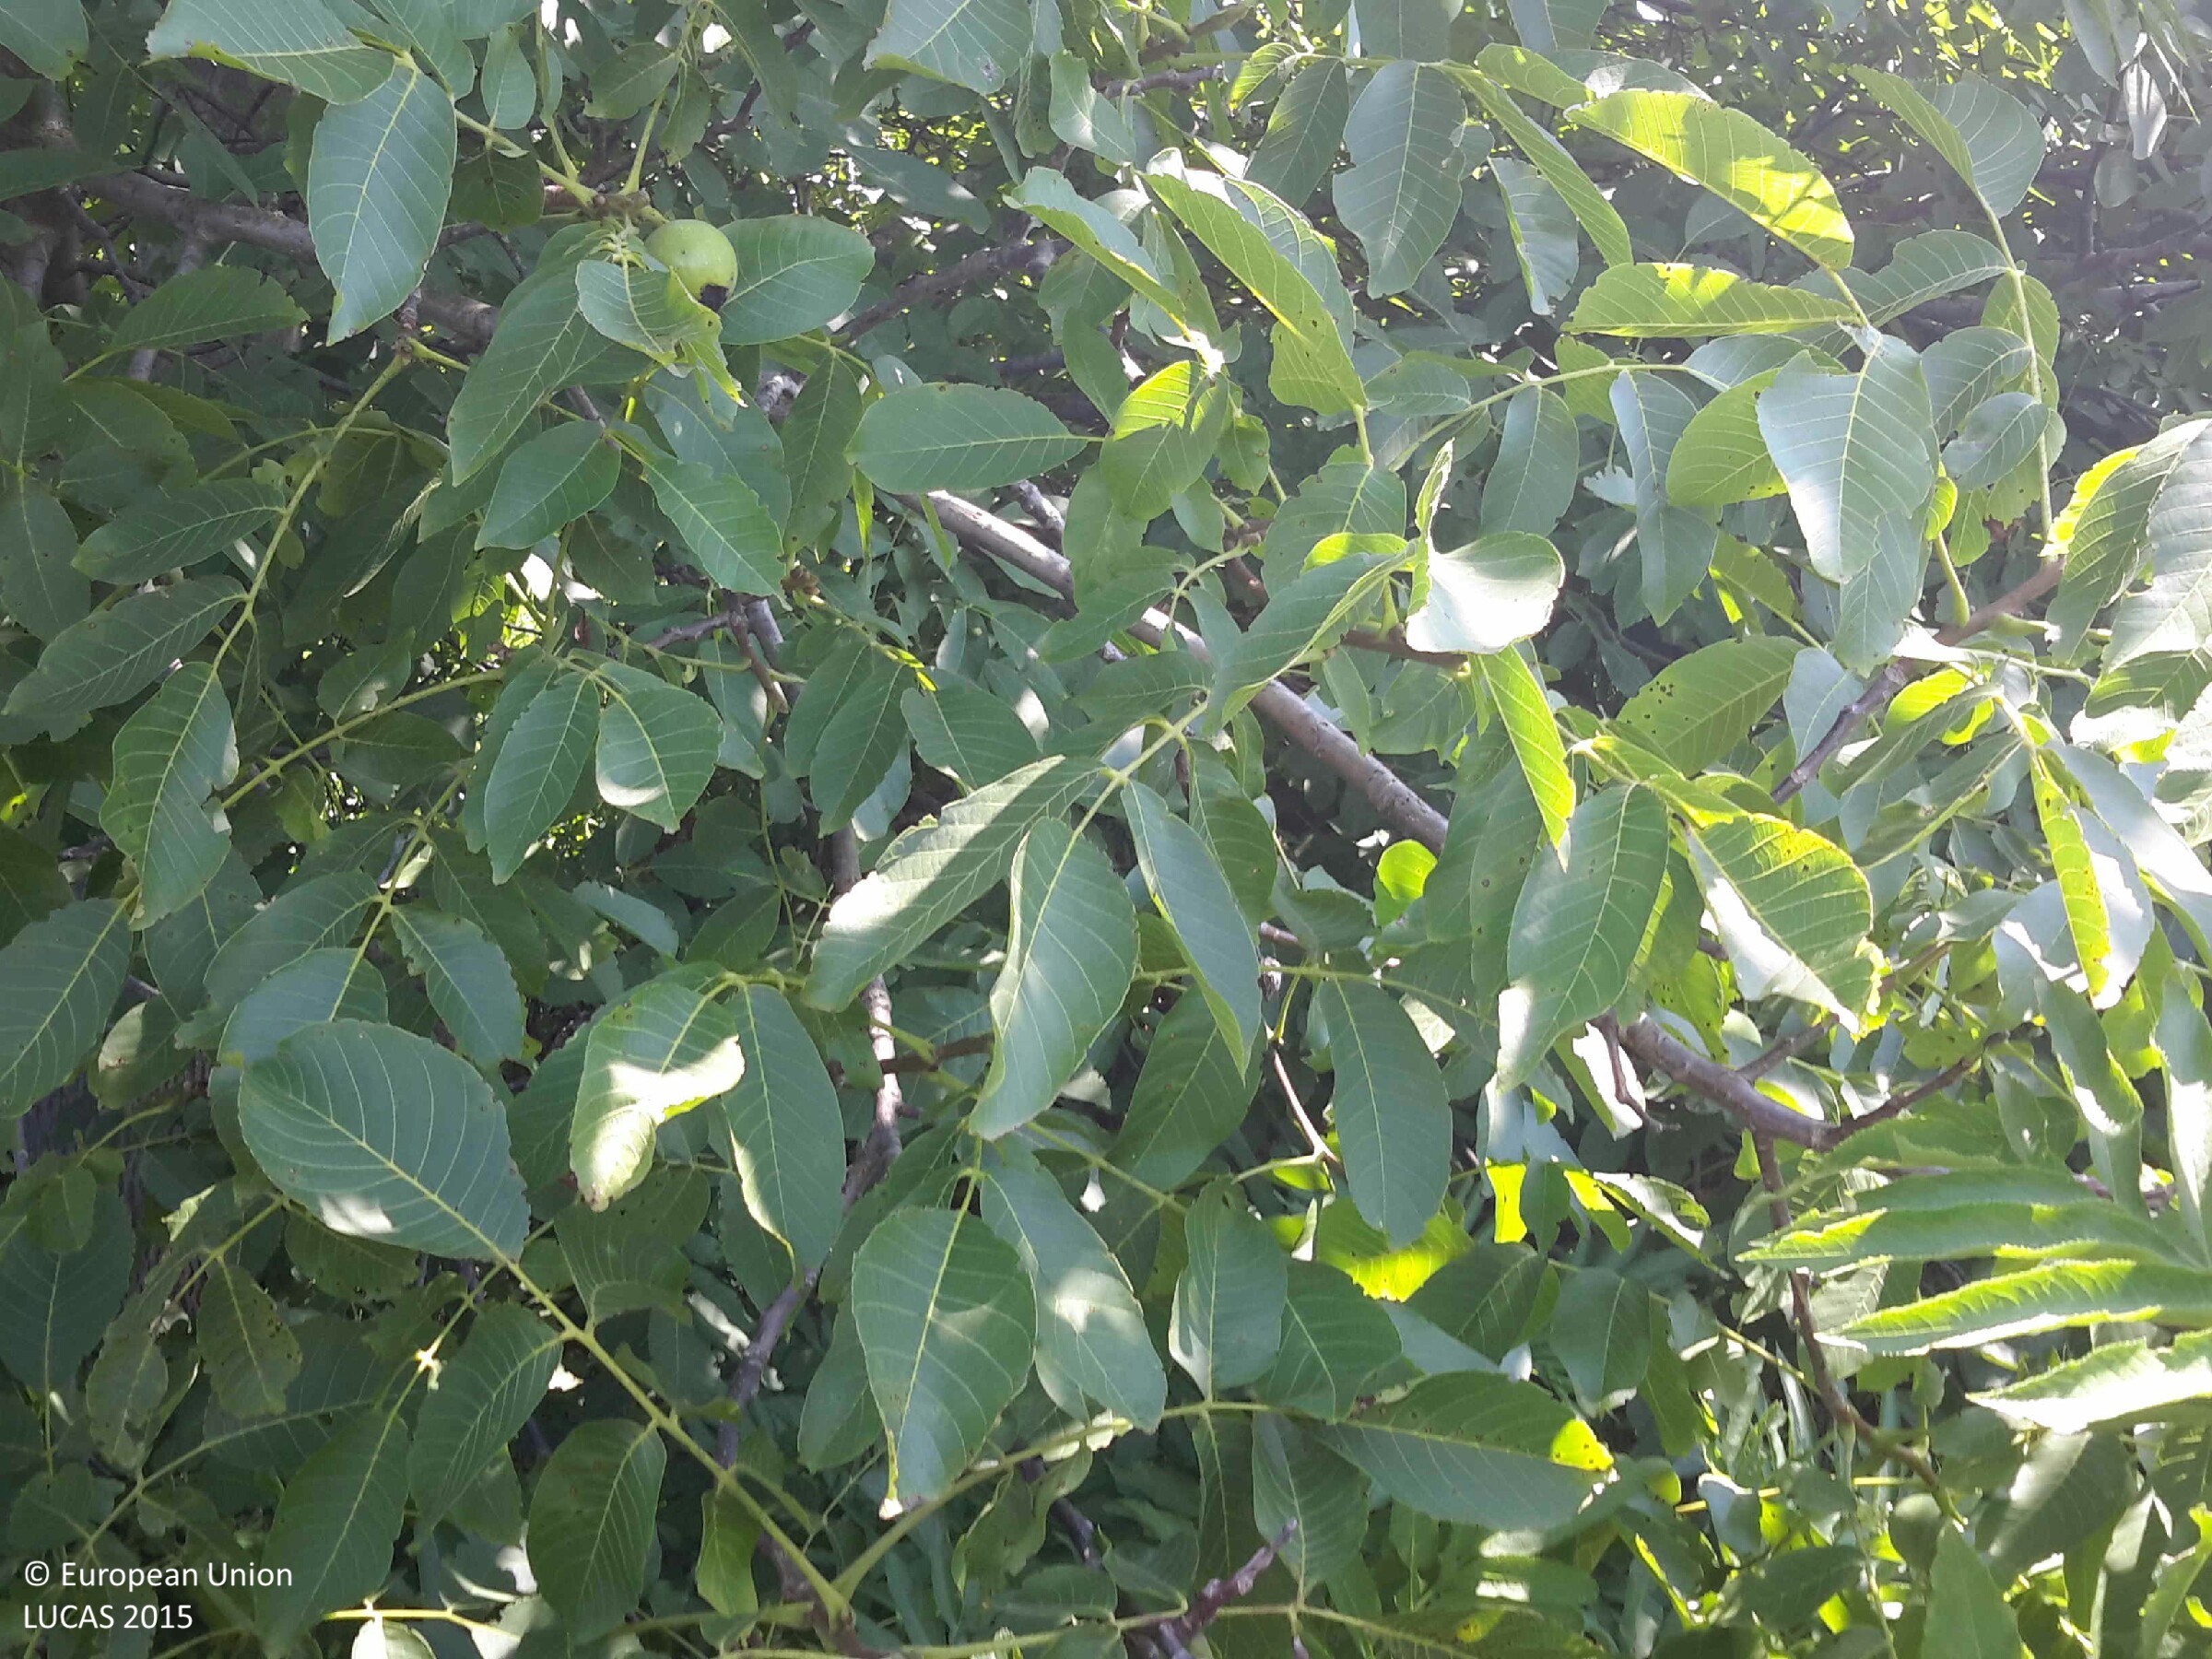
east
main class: Shrubland
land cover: Shrubland with sparse tree cover
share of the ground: 25 - 50 %
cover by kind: herbaceous plants 70 %, shrubs 25 %, broadleaved forest trees 5 %
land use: Semi-natural and natural areas not in use
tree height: > 5 m
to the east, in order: Shrubland with sparse tree cover; Grass margins; Tracks; Grassland with sparse tree/shrub cover; Paved roads, cycling and walking lanes; Grass margins; Fences; Artificial constructions in urban areas; Broadleaved woodland
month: July
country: HU
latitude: 47.4393
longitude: 17.8197
